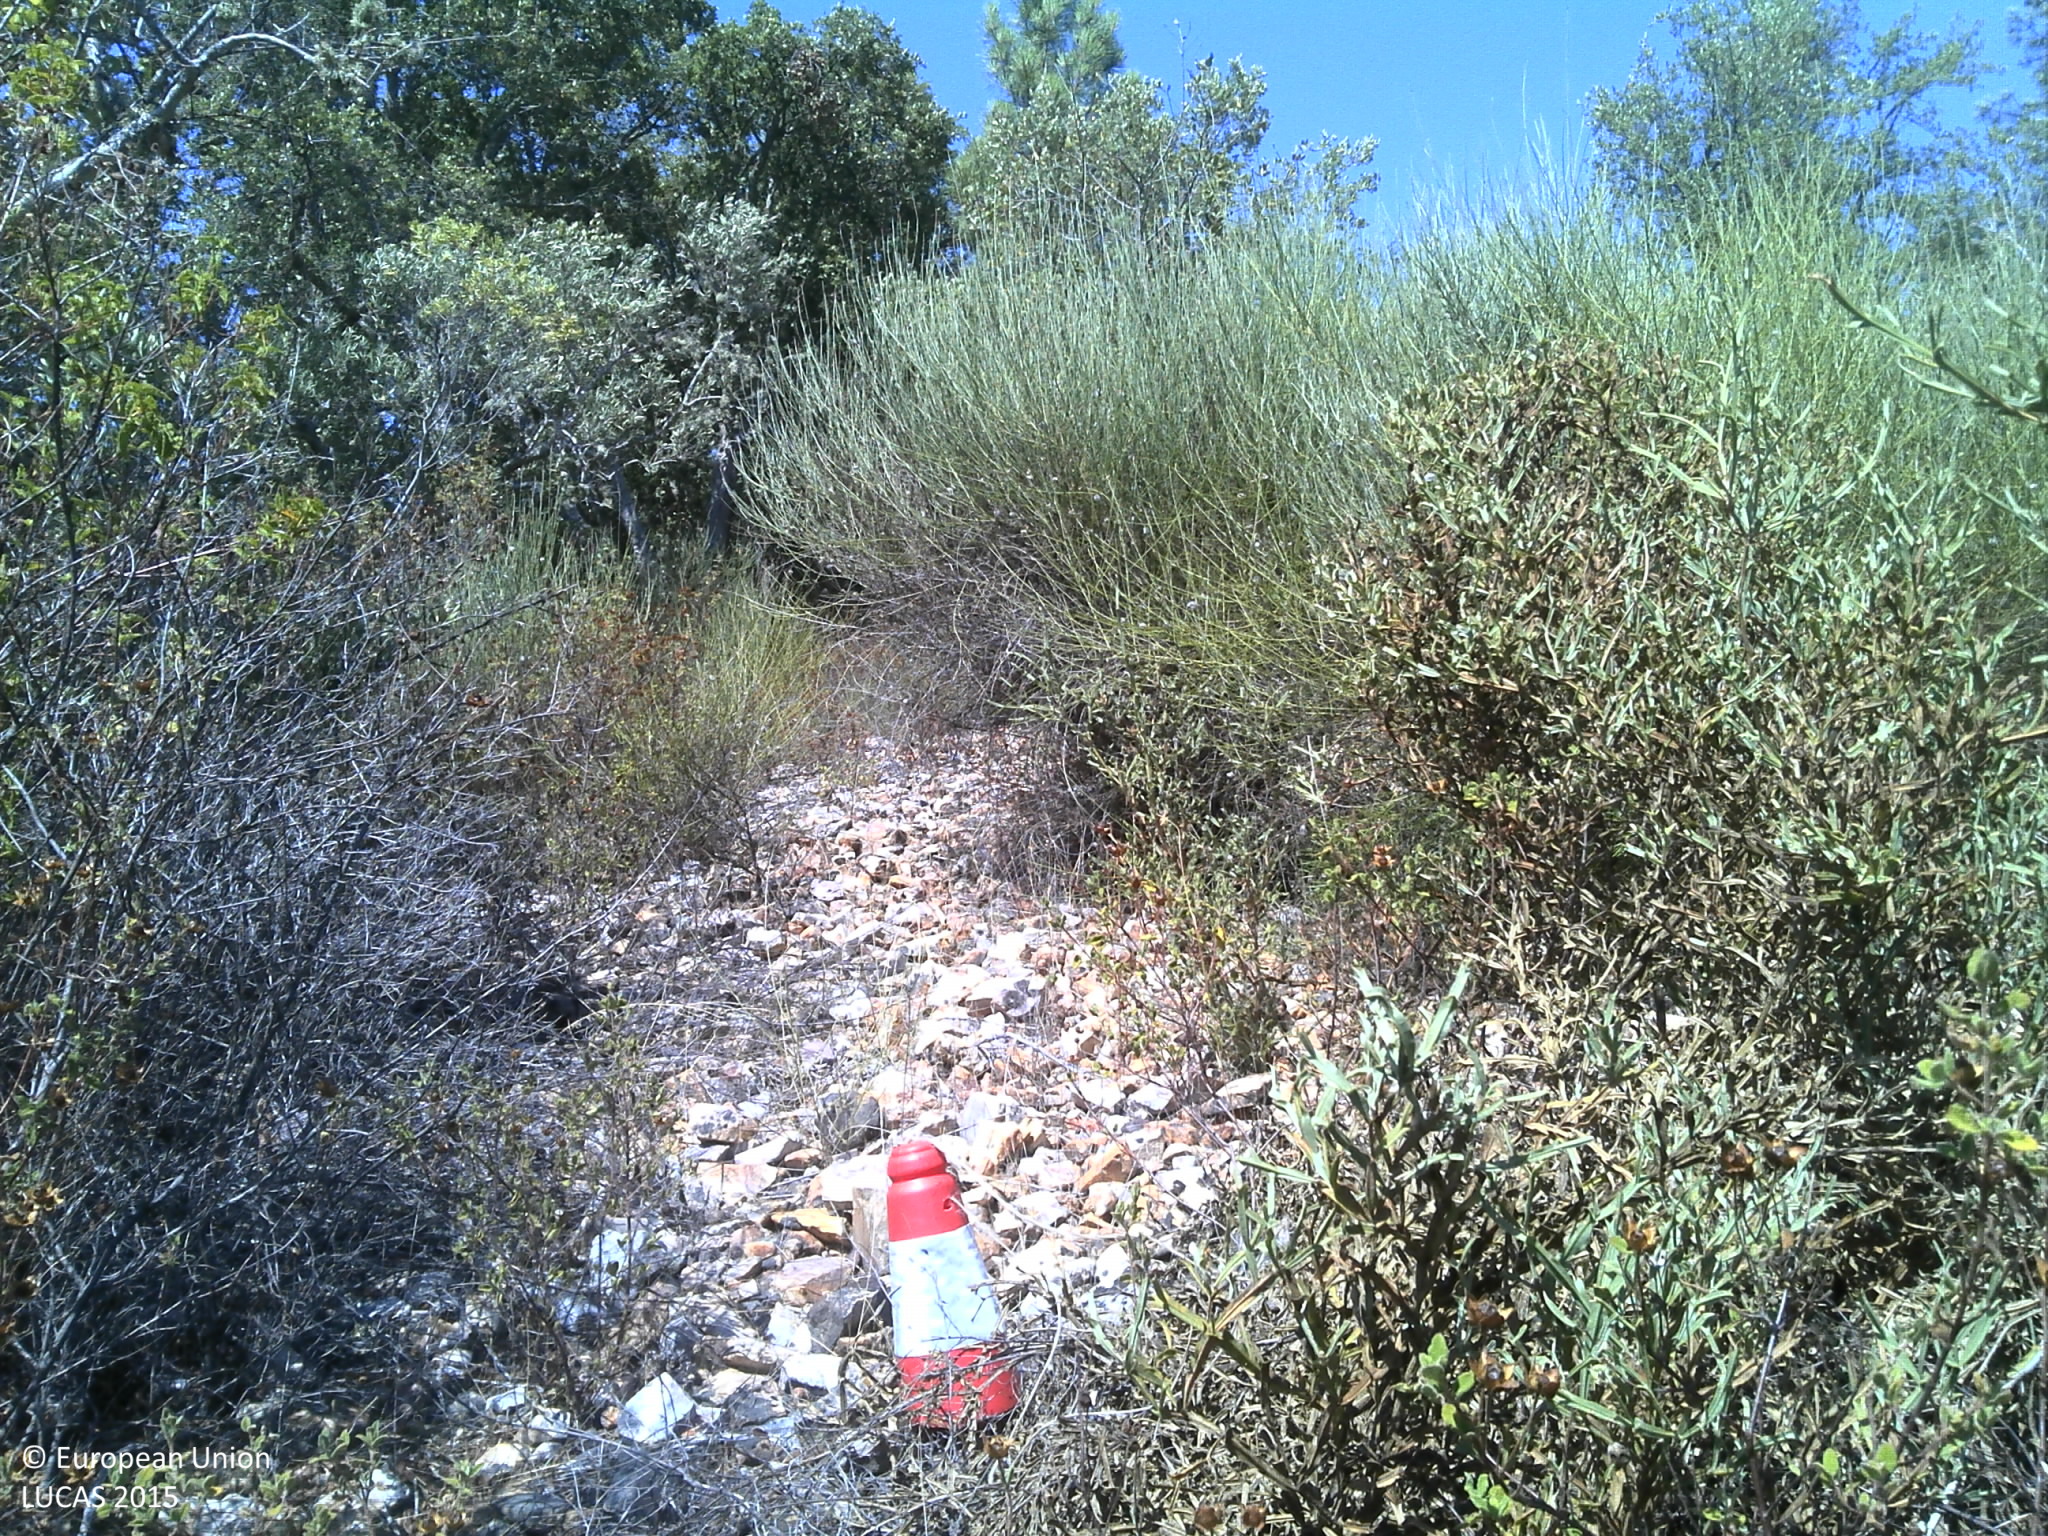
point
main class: Woodland
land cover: Broadleaved woodland
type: thermophilous deciduous forest
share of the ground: 50 - 75 %
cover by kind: broadleaved forest trees 60 %, shrubs 25 %, herbaceous plants 5 %, unconsolidated bare surface 5 %
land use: Forestry
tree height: > 5 m
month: June
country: PT
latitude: 39.7317
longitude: -7.3027
